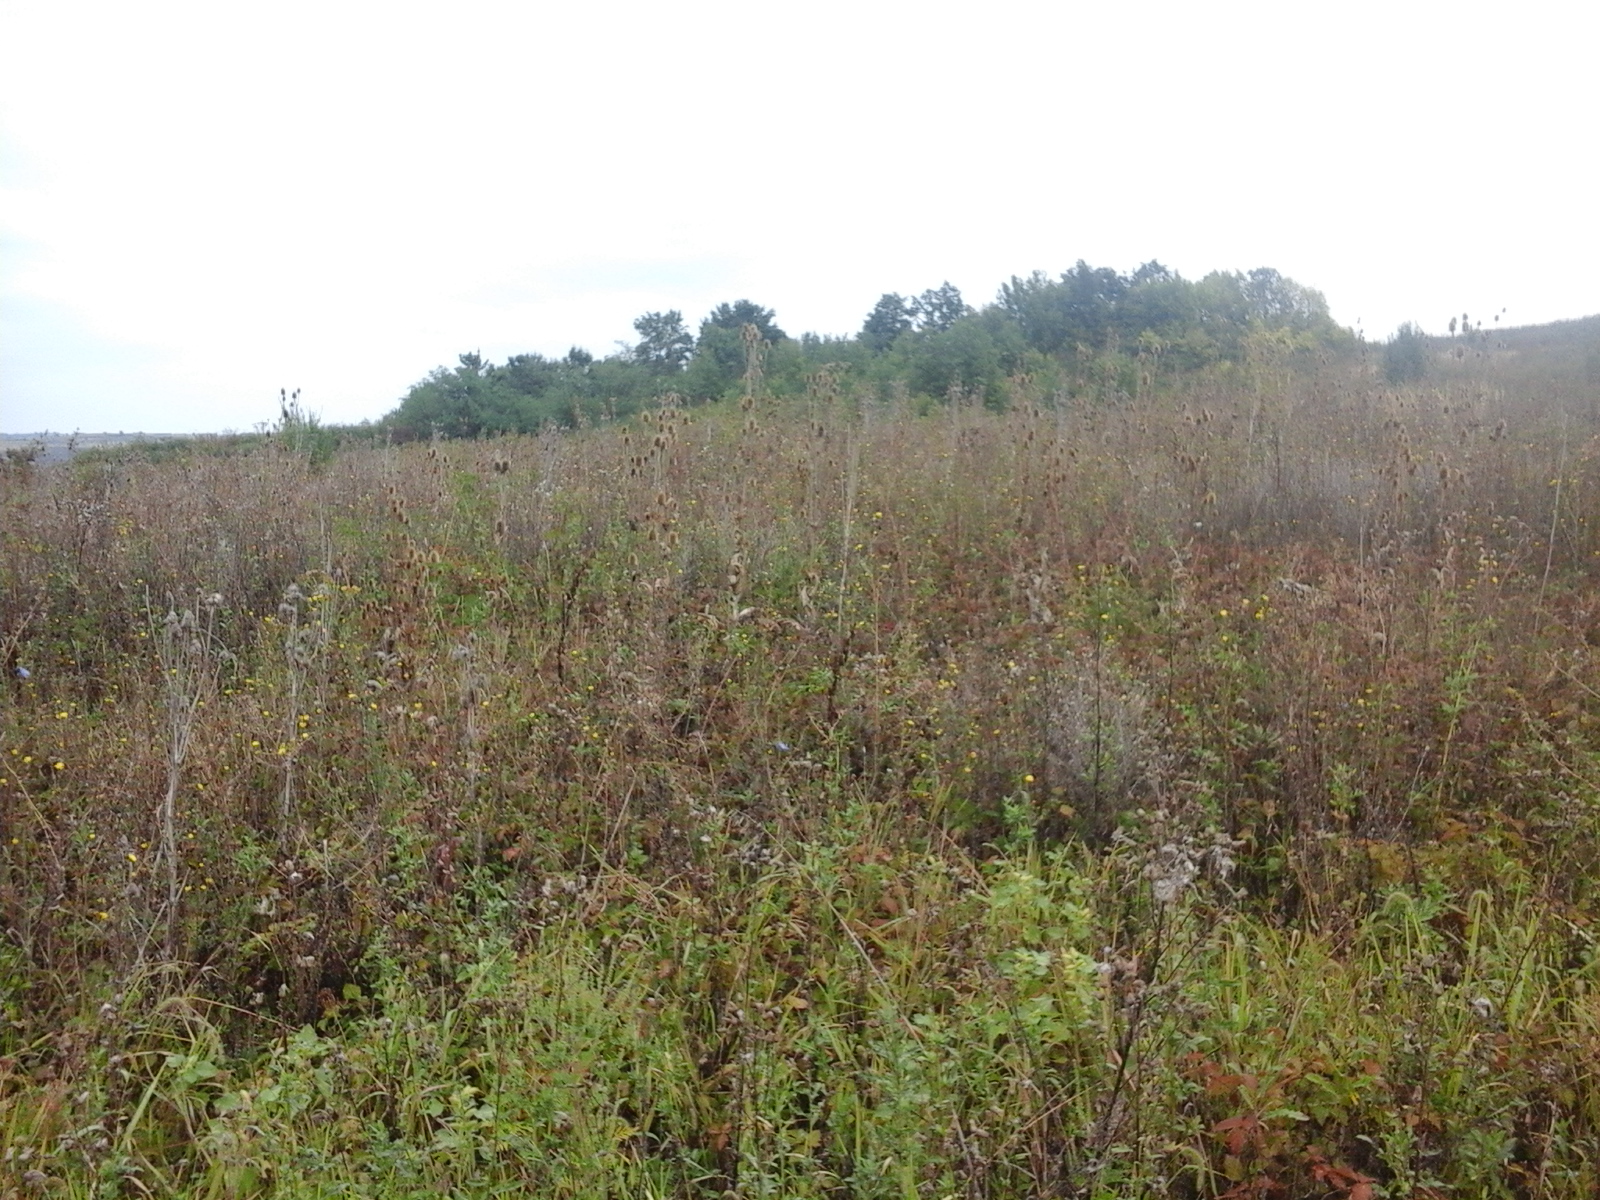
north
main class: Grassland
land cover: Spontaneously vegetated surfaces
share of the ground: > 75 %
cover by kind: herbaceous plants 100 %
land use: Fallow land
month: September
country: RO
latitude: 47.3021
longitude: 22.5551
